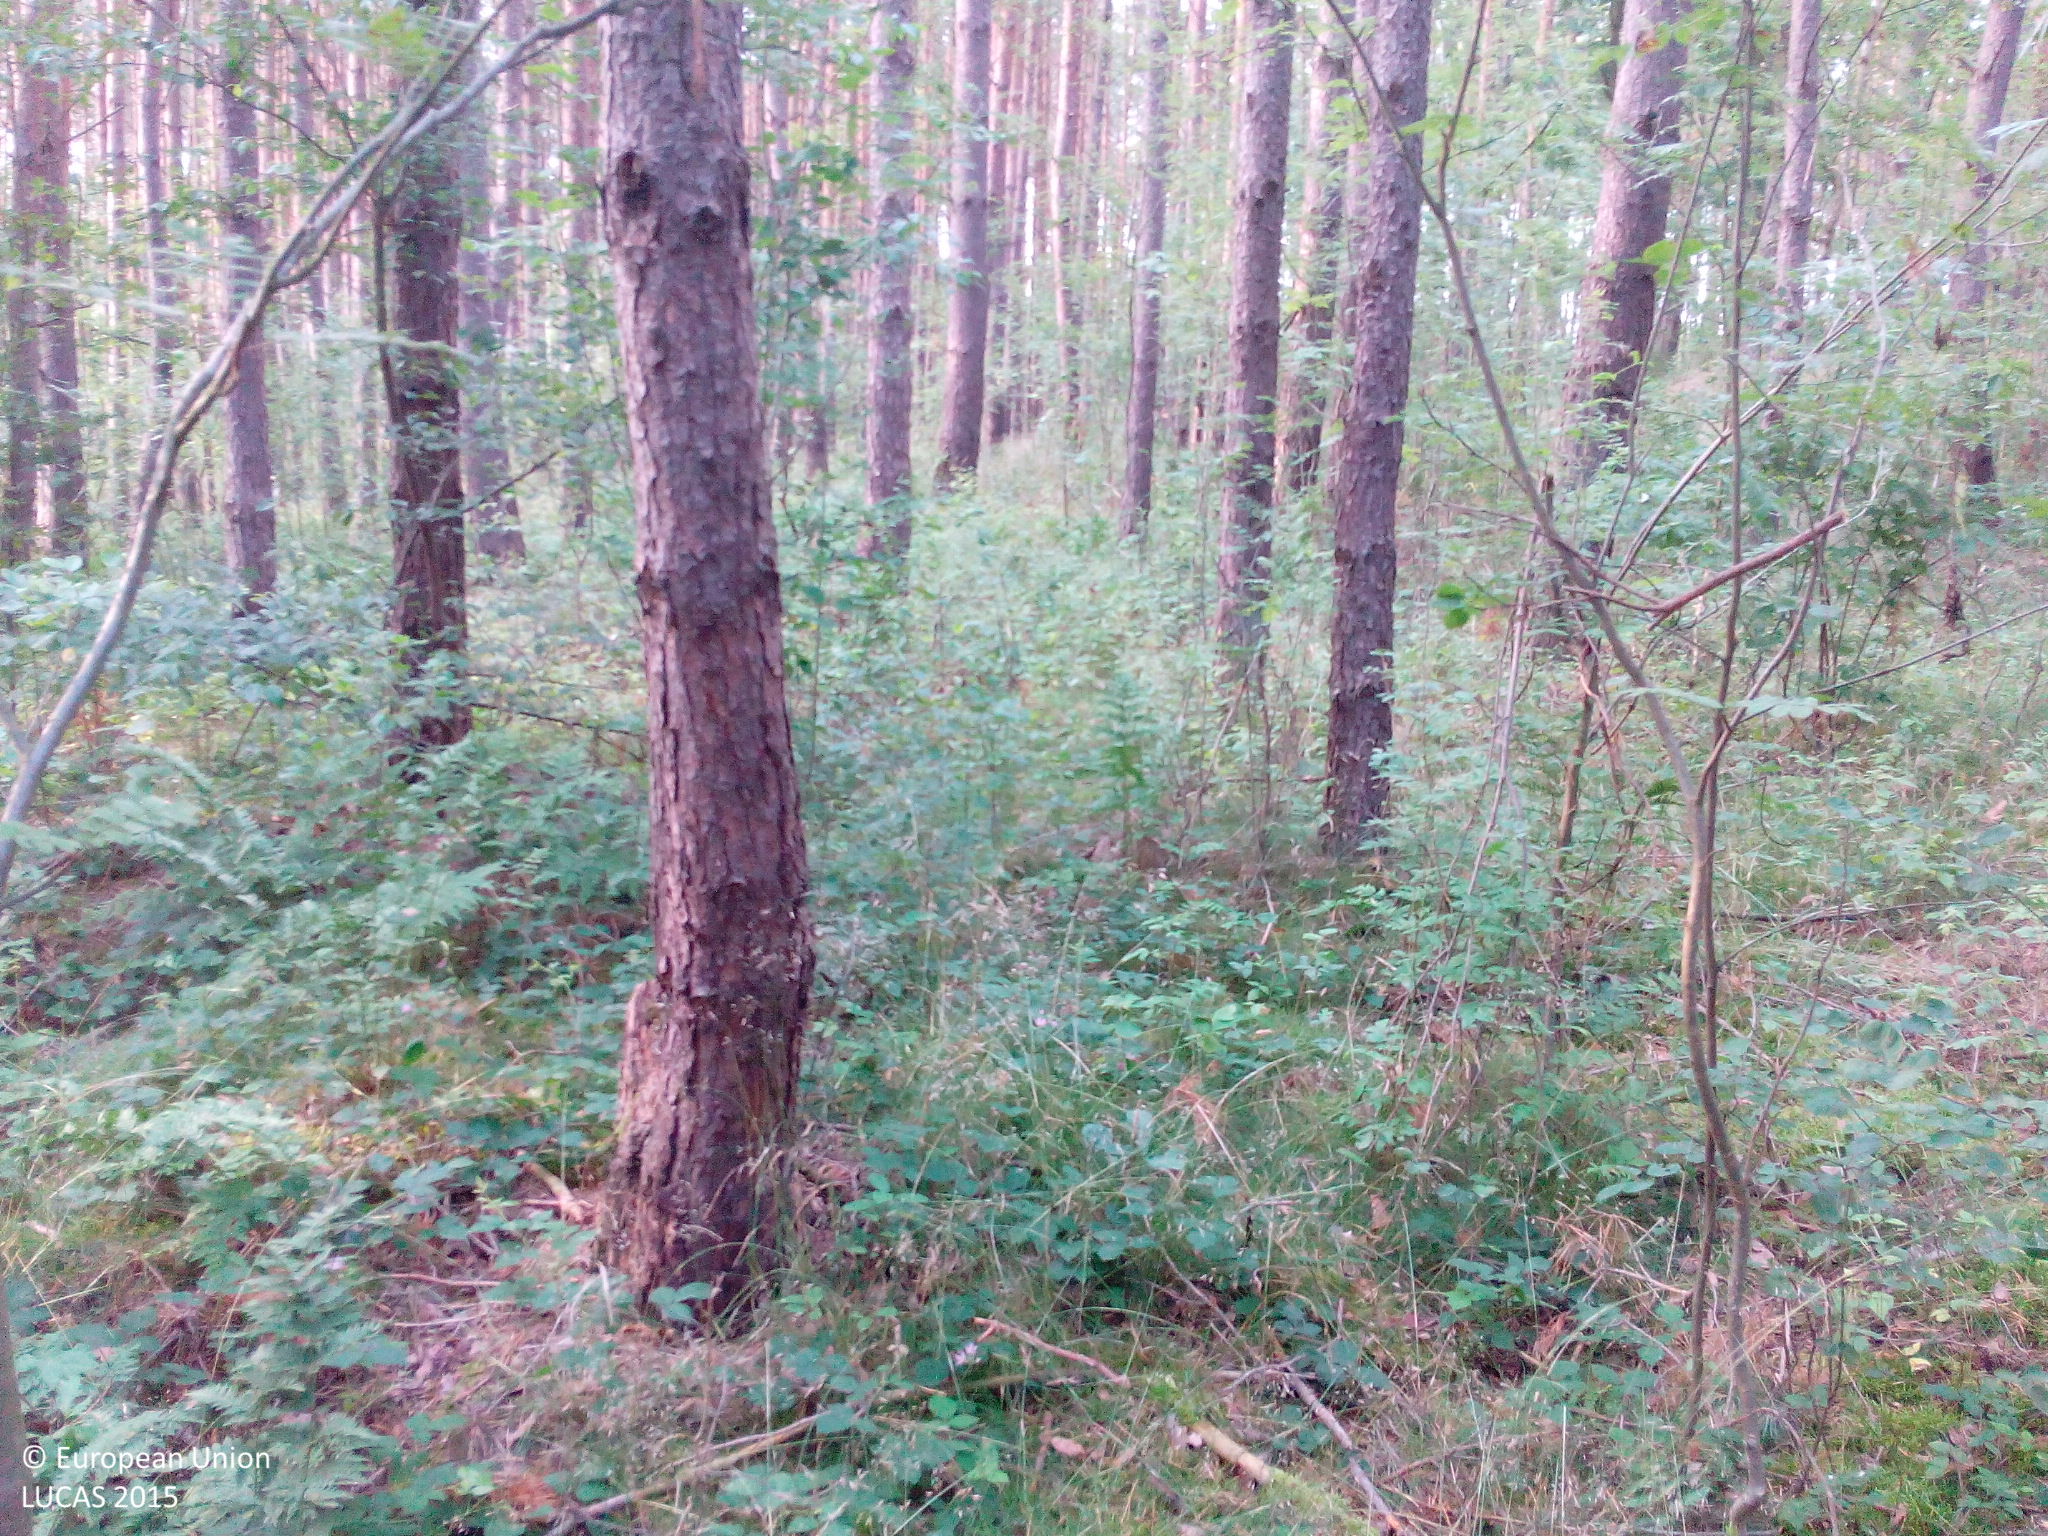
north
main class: Woodland
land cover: Pine dominated mixed woodland
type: hemiboreal forest and nemoral coniferous forest and mixed broadleaved-coniferous forest
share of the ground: 50 - 75 %
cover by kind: coniferous forest trees 45 %, broadleaved forest trees 25 %, shrubs 15 %, herbaceous plants 15 %
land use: Forestry
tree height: > 5 m
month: July
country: DE
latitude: 53.4878
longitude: 14.2960
